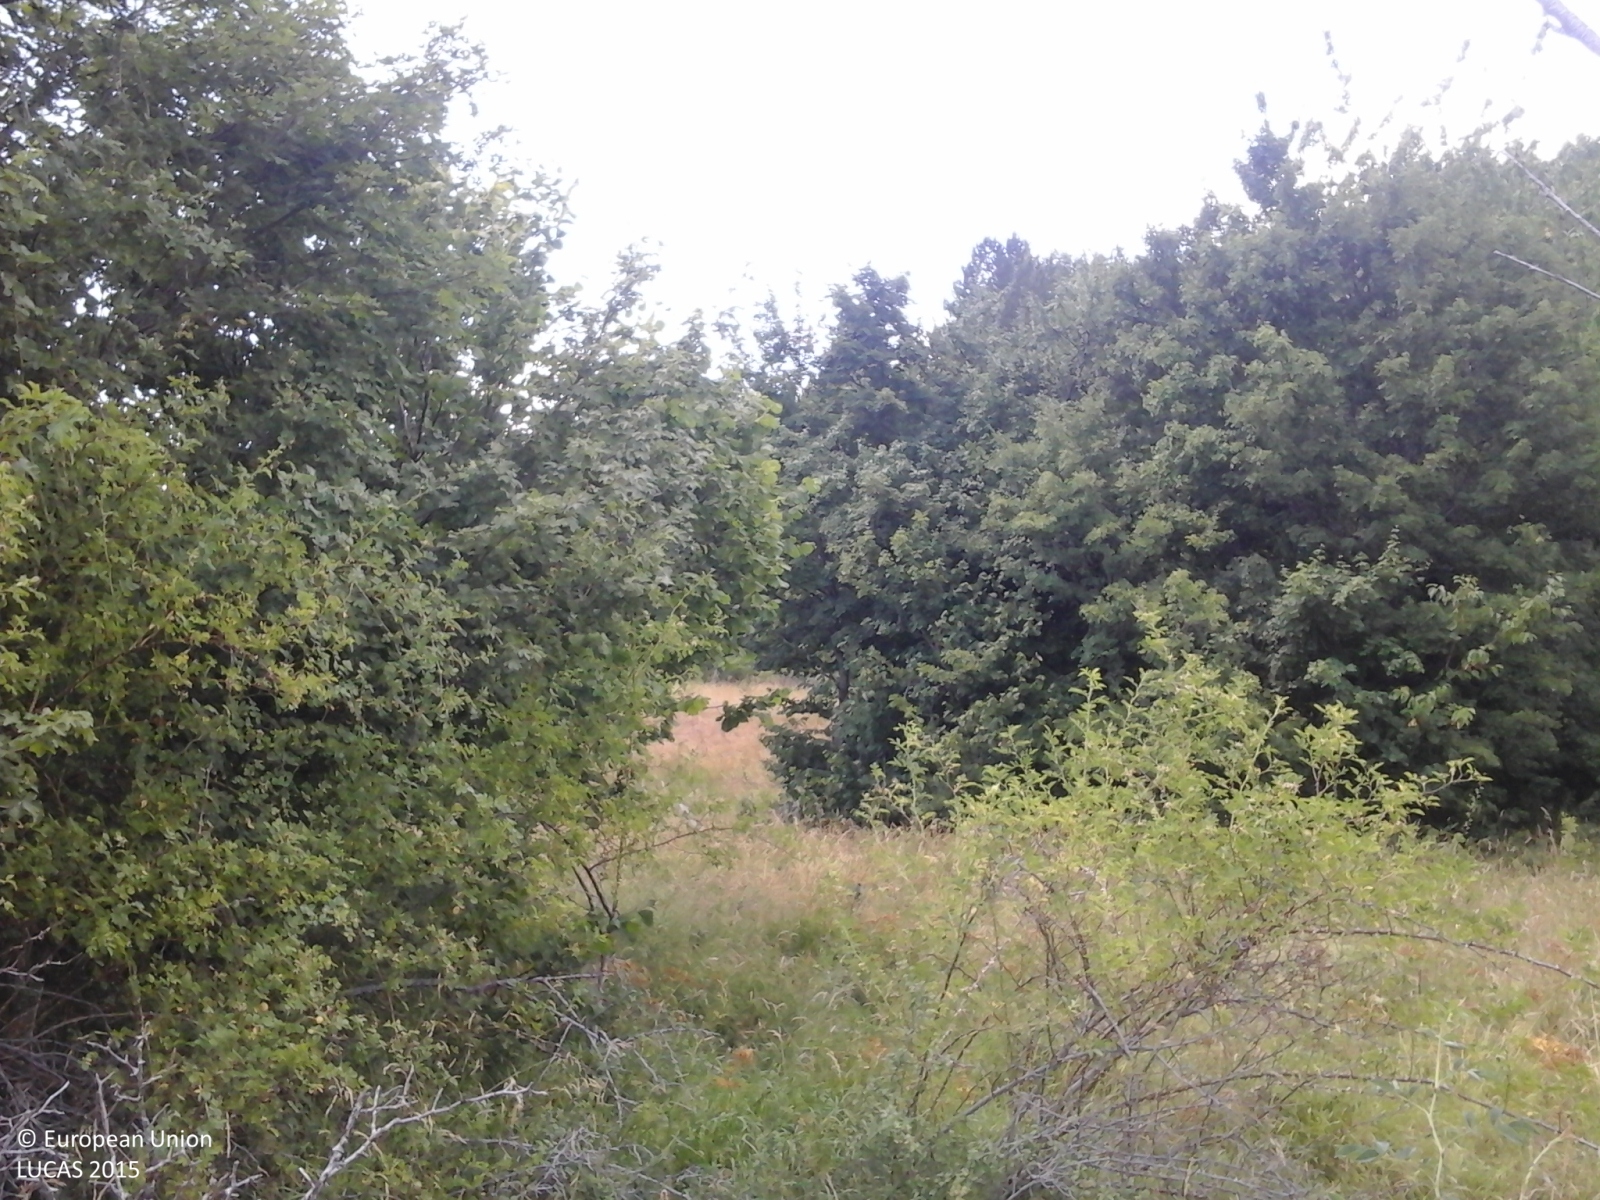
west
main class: Grassland
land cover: Grassland with sparse tree/shrub cover
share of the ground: > 75 %
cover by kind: herbaceous plants 90 %, broadleaved forest trees 5 %, shrubs 5 %
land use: Agriculture (excluding fallow land and kitchen gardens)
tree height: > 5 m
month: July
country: IT
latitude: 44.2046
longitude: 10.5868
